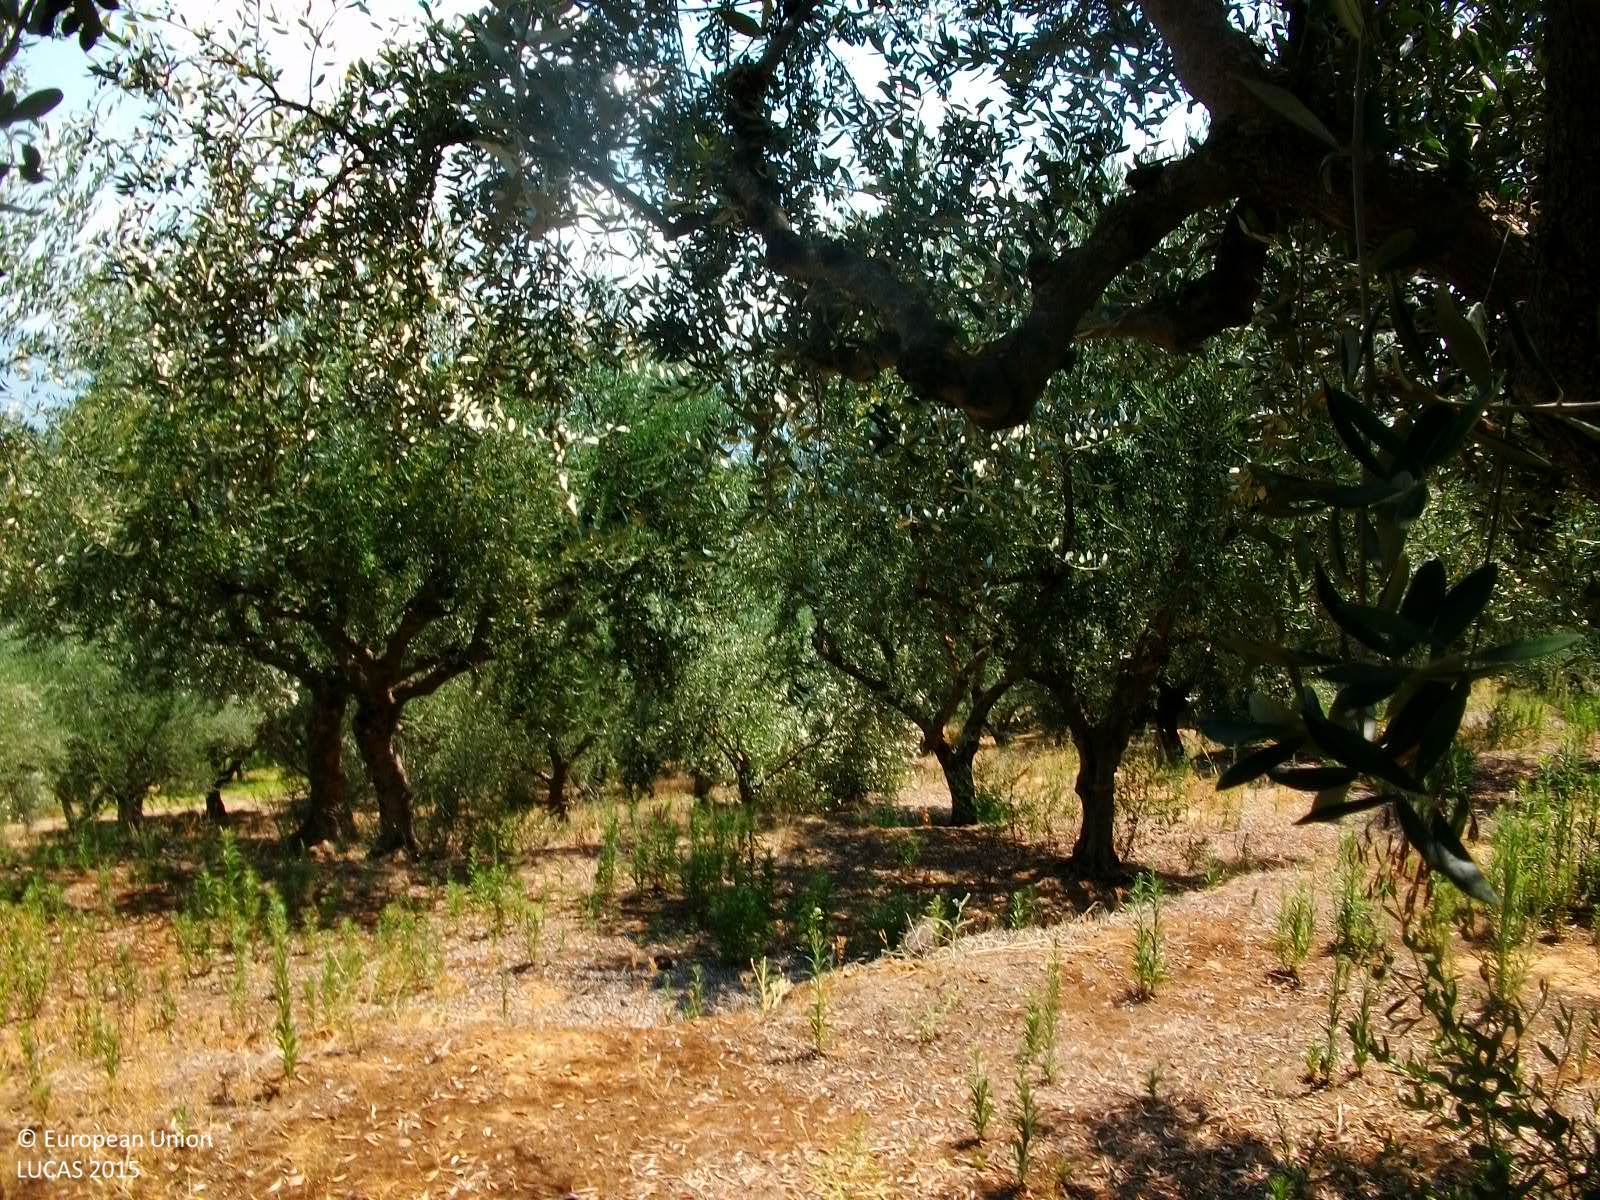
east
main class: Cropland
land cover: Olive groves
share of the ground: > 75 %
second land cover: Spontaneously vegetated surfaces
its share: > 75 %
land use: Agriculture (excluding fallow land and kitchen gardens)
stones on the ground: < 10 %
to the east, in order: Olive groves; Spontaneously vegetated surfaces; Grass margins; Tracks; Grass margins; Olive groves; Ditches and canals; Olive groves; Grass margins; Tracks; Grass margins; Olive groves
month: August
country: GR
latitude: 37.1083
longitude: 21.8928
